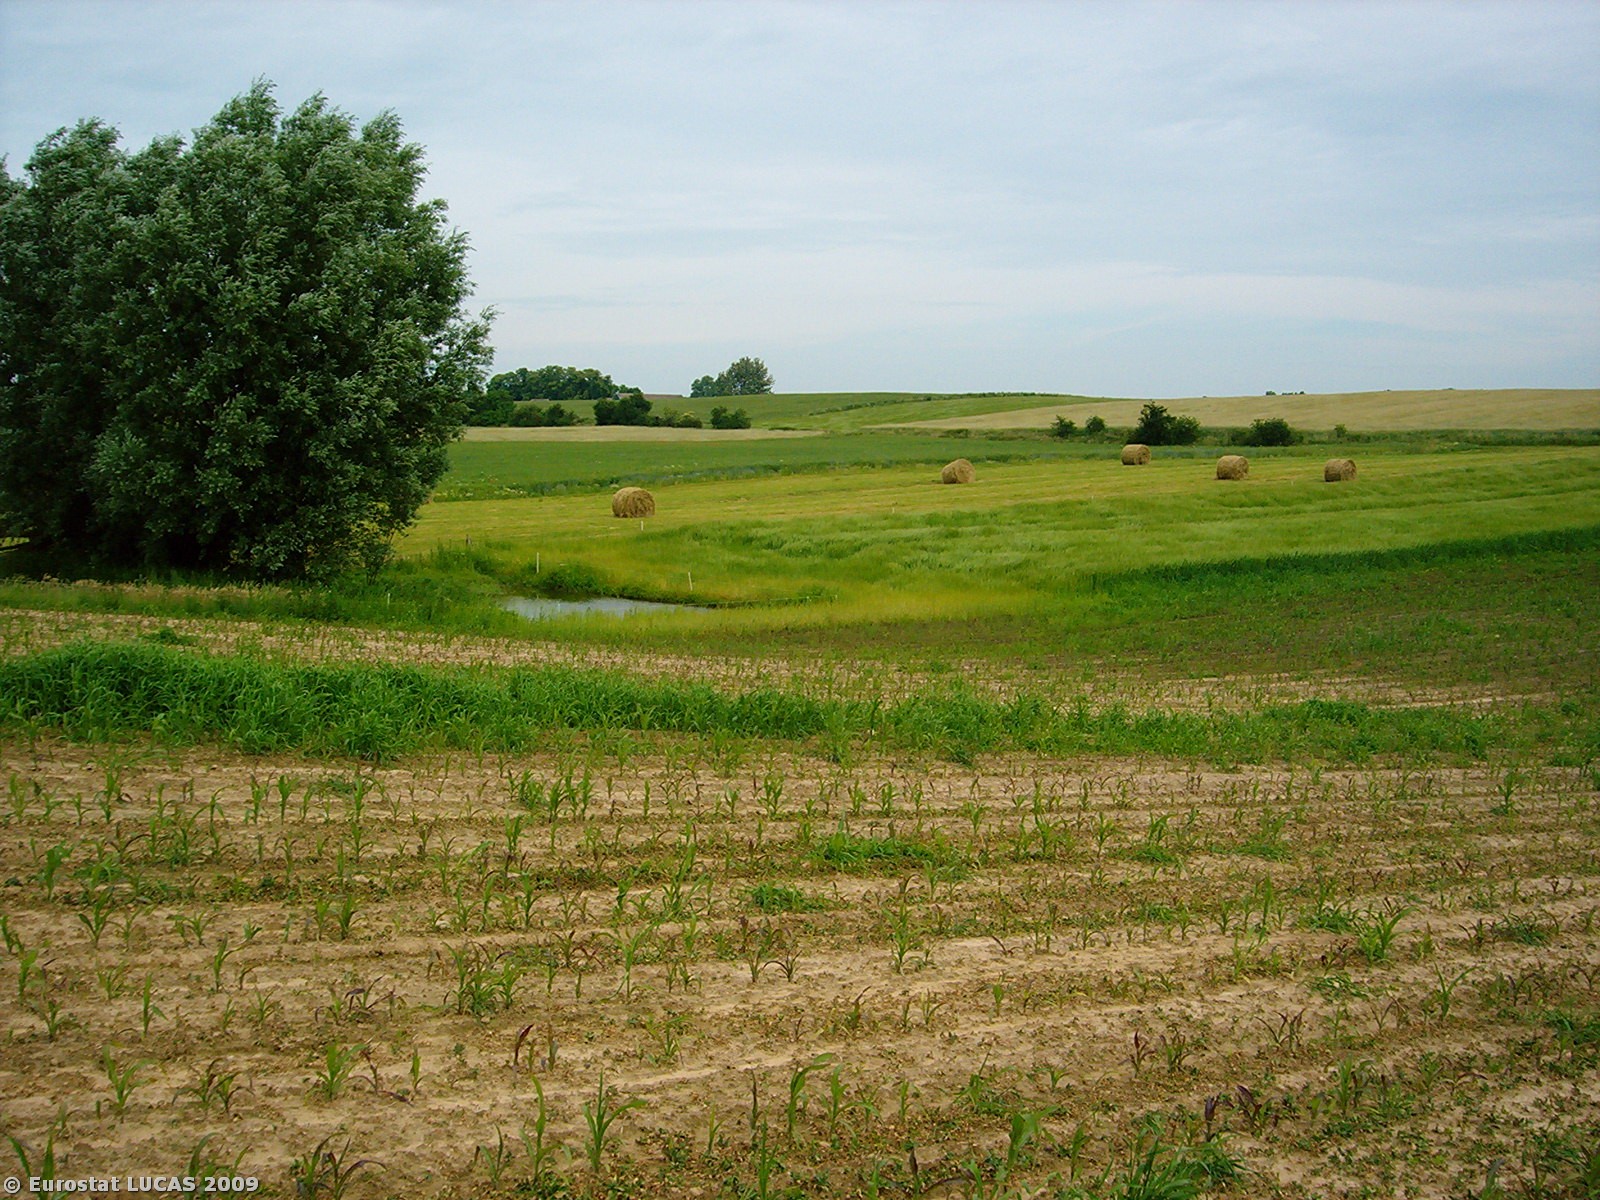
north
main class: Cropland
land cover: Maize
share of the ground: 10 - 25 %
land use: Agriculture (excluding fallow land and kitchen gardens)
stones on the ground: < 10 %
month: June
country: PL
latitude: 53.0989
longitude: 15.4547
